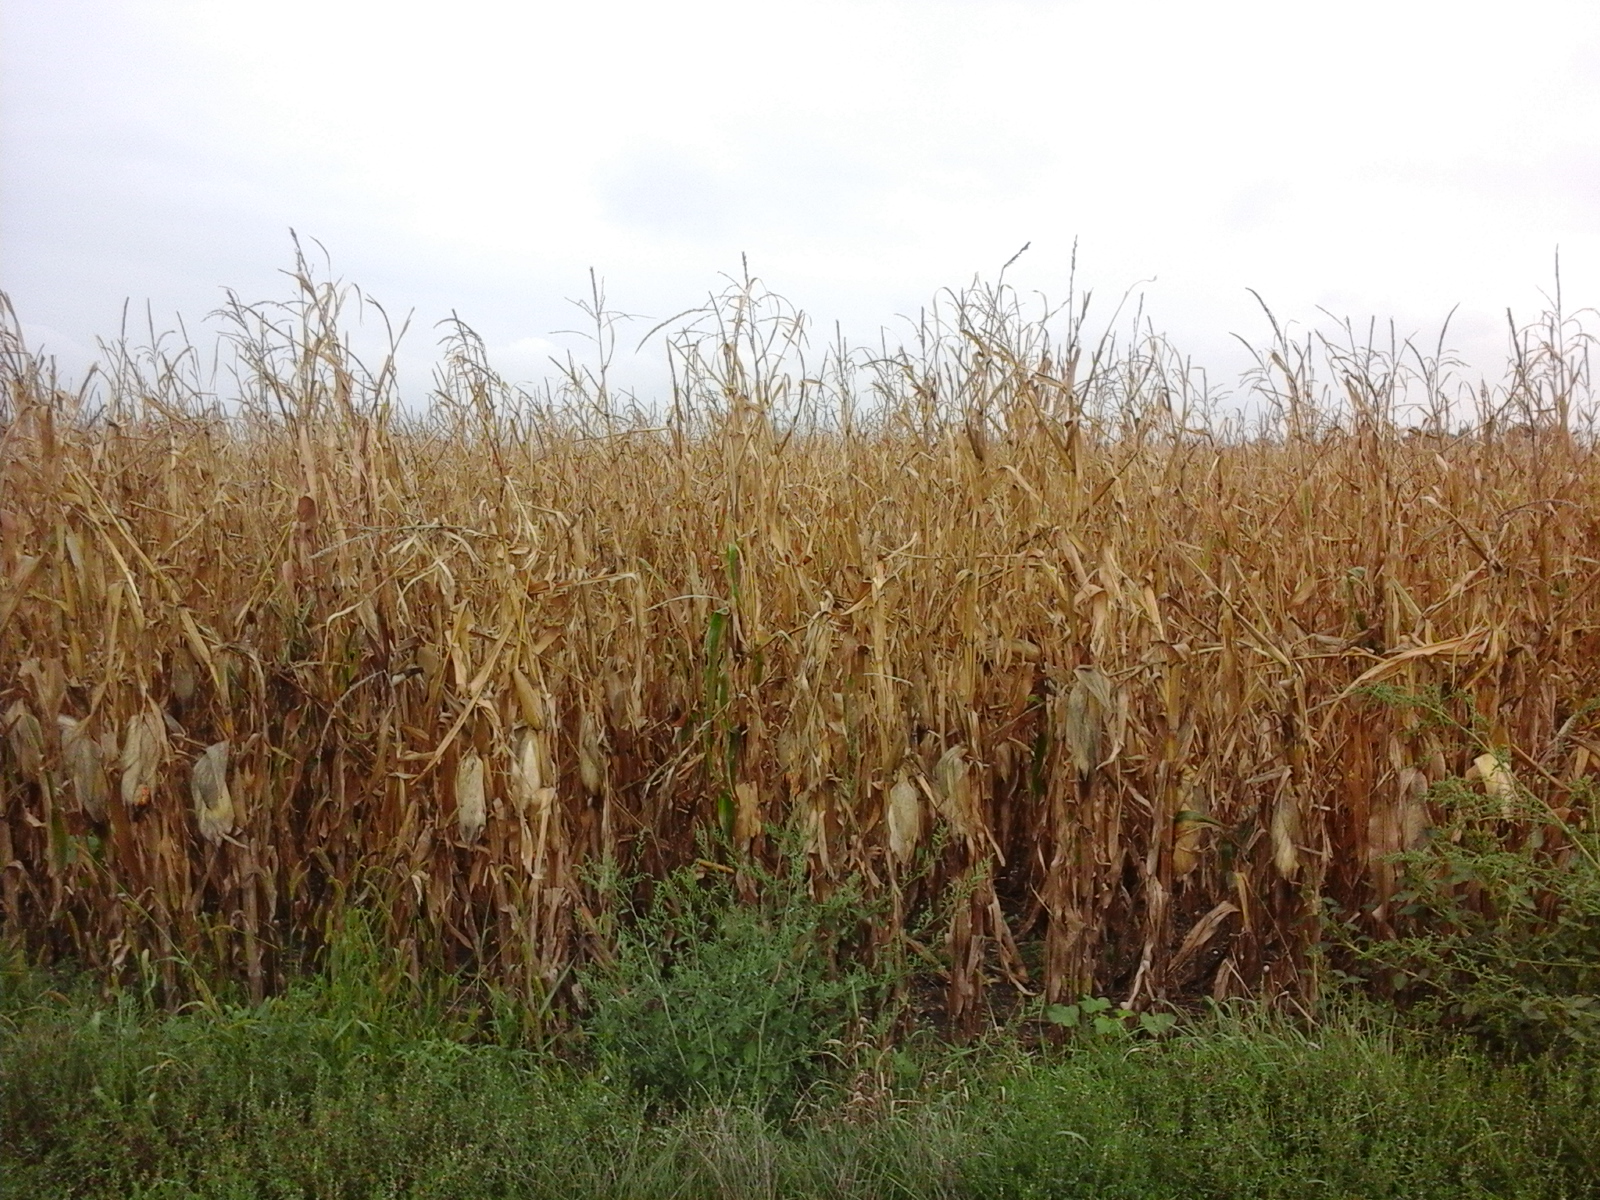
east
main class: Cropland
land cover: Maize
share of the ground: > 75 %
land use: Agriculture (excluding fallow land and kitchen gardens)
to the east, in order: Maize; Other bare soil; Maize; Grass margins; Tracks; Spontaneously vegetated surfaces; Maize
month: September
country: RO
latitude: 47.1101
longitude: 21.8399
